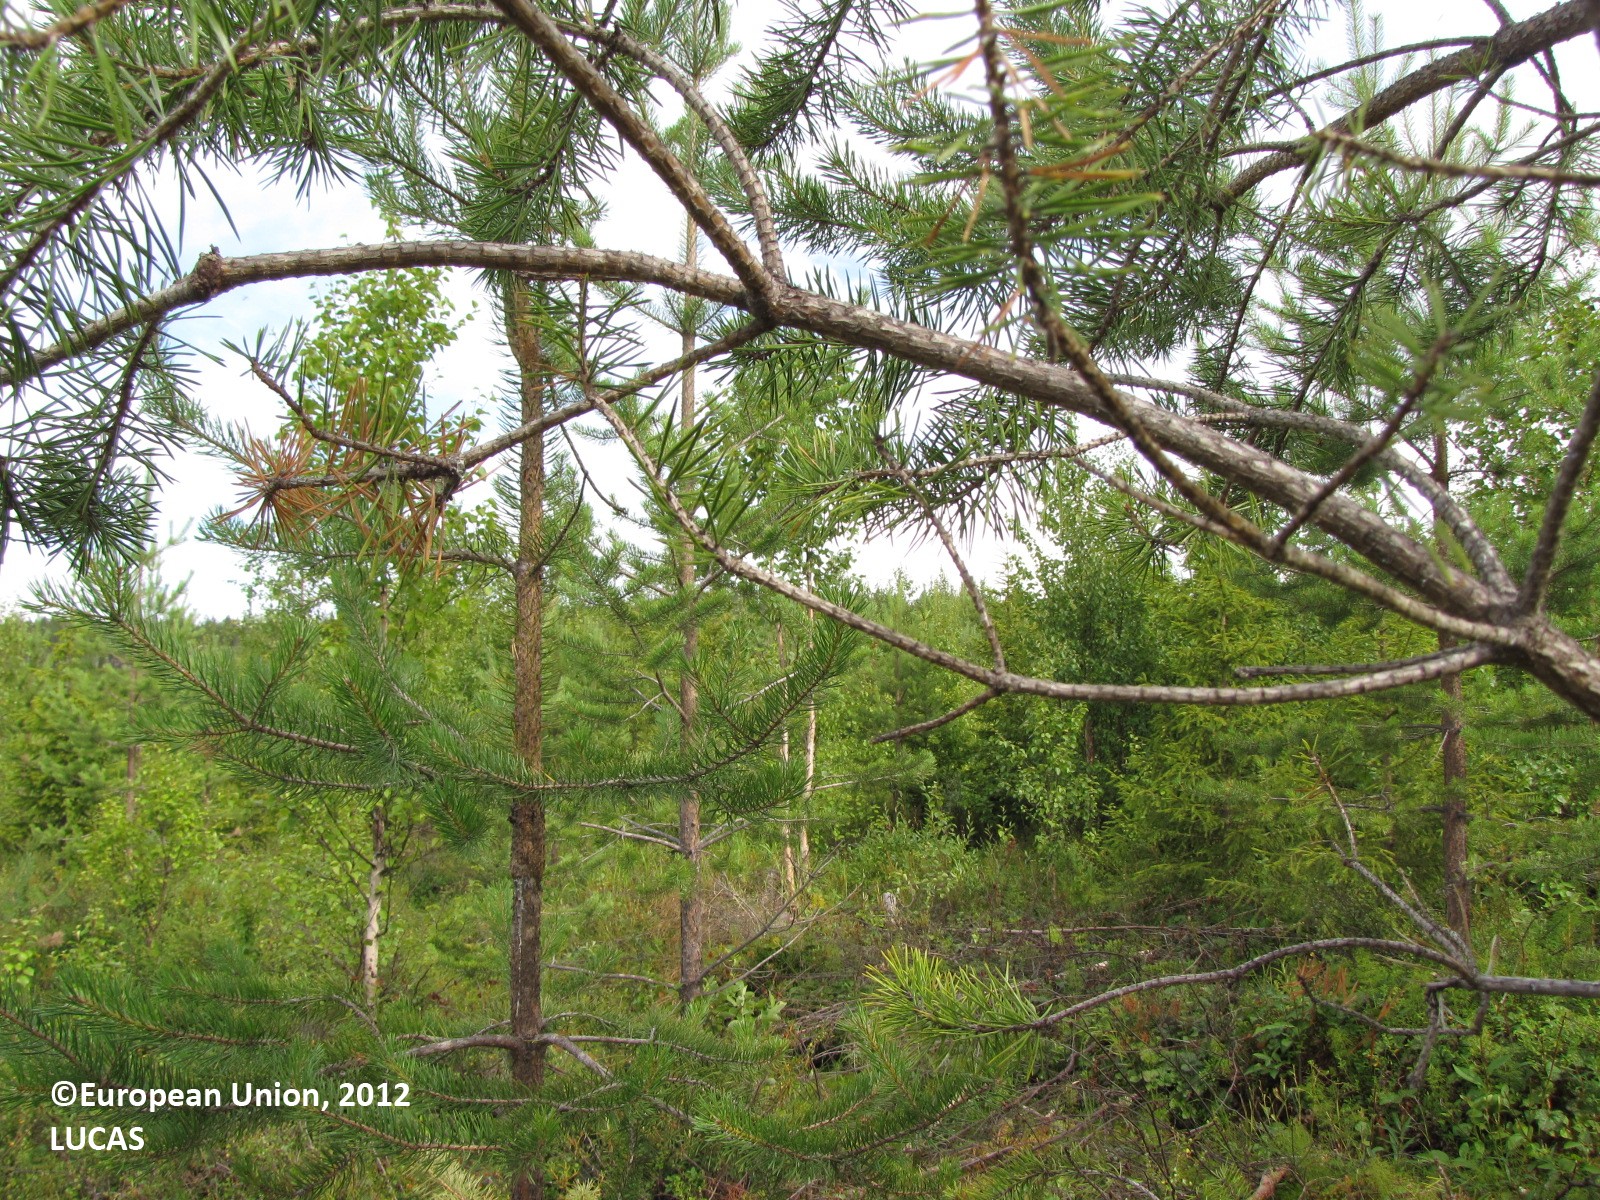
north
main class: Woodland
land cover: Pine dominated mixed woodland
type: boreal forest
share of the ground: 25 - 50 %
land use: Forestry
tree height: > 5 m
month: August
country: FI
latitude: 66.7328
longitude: 24.5385
